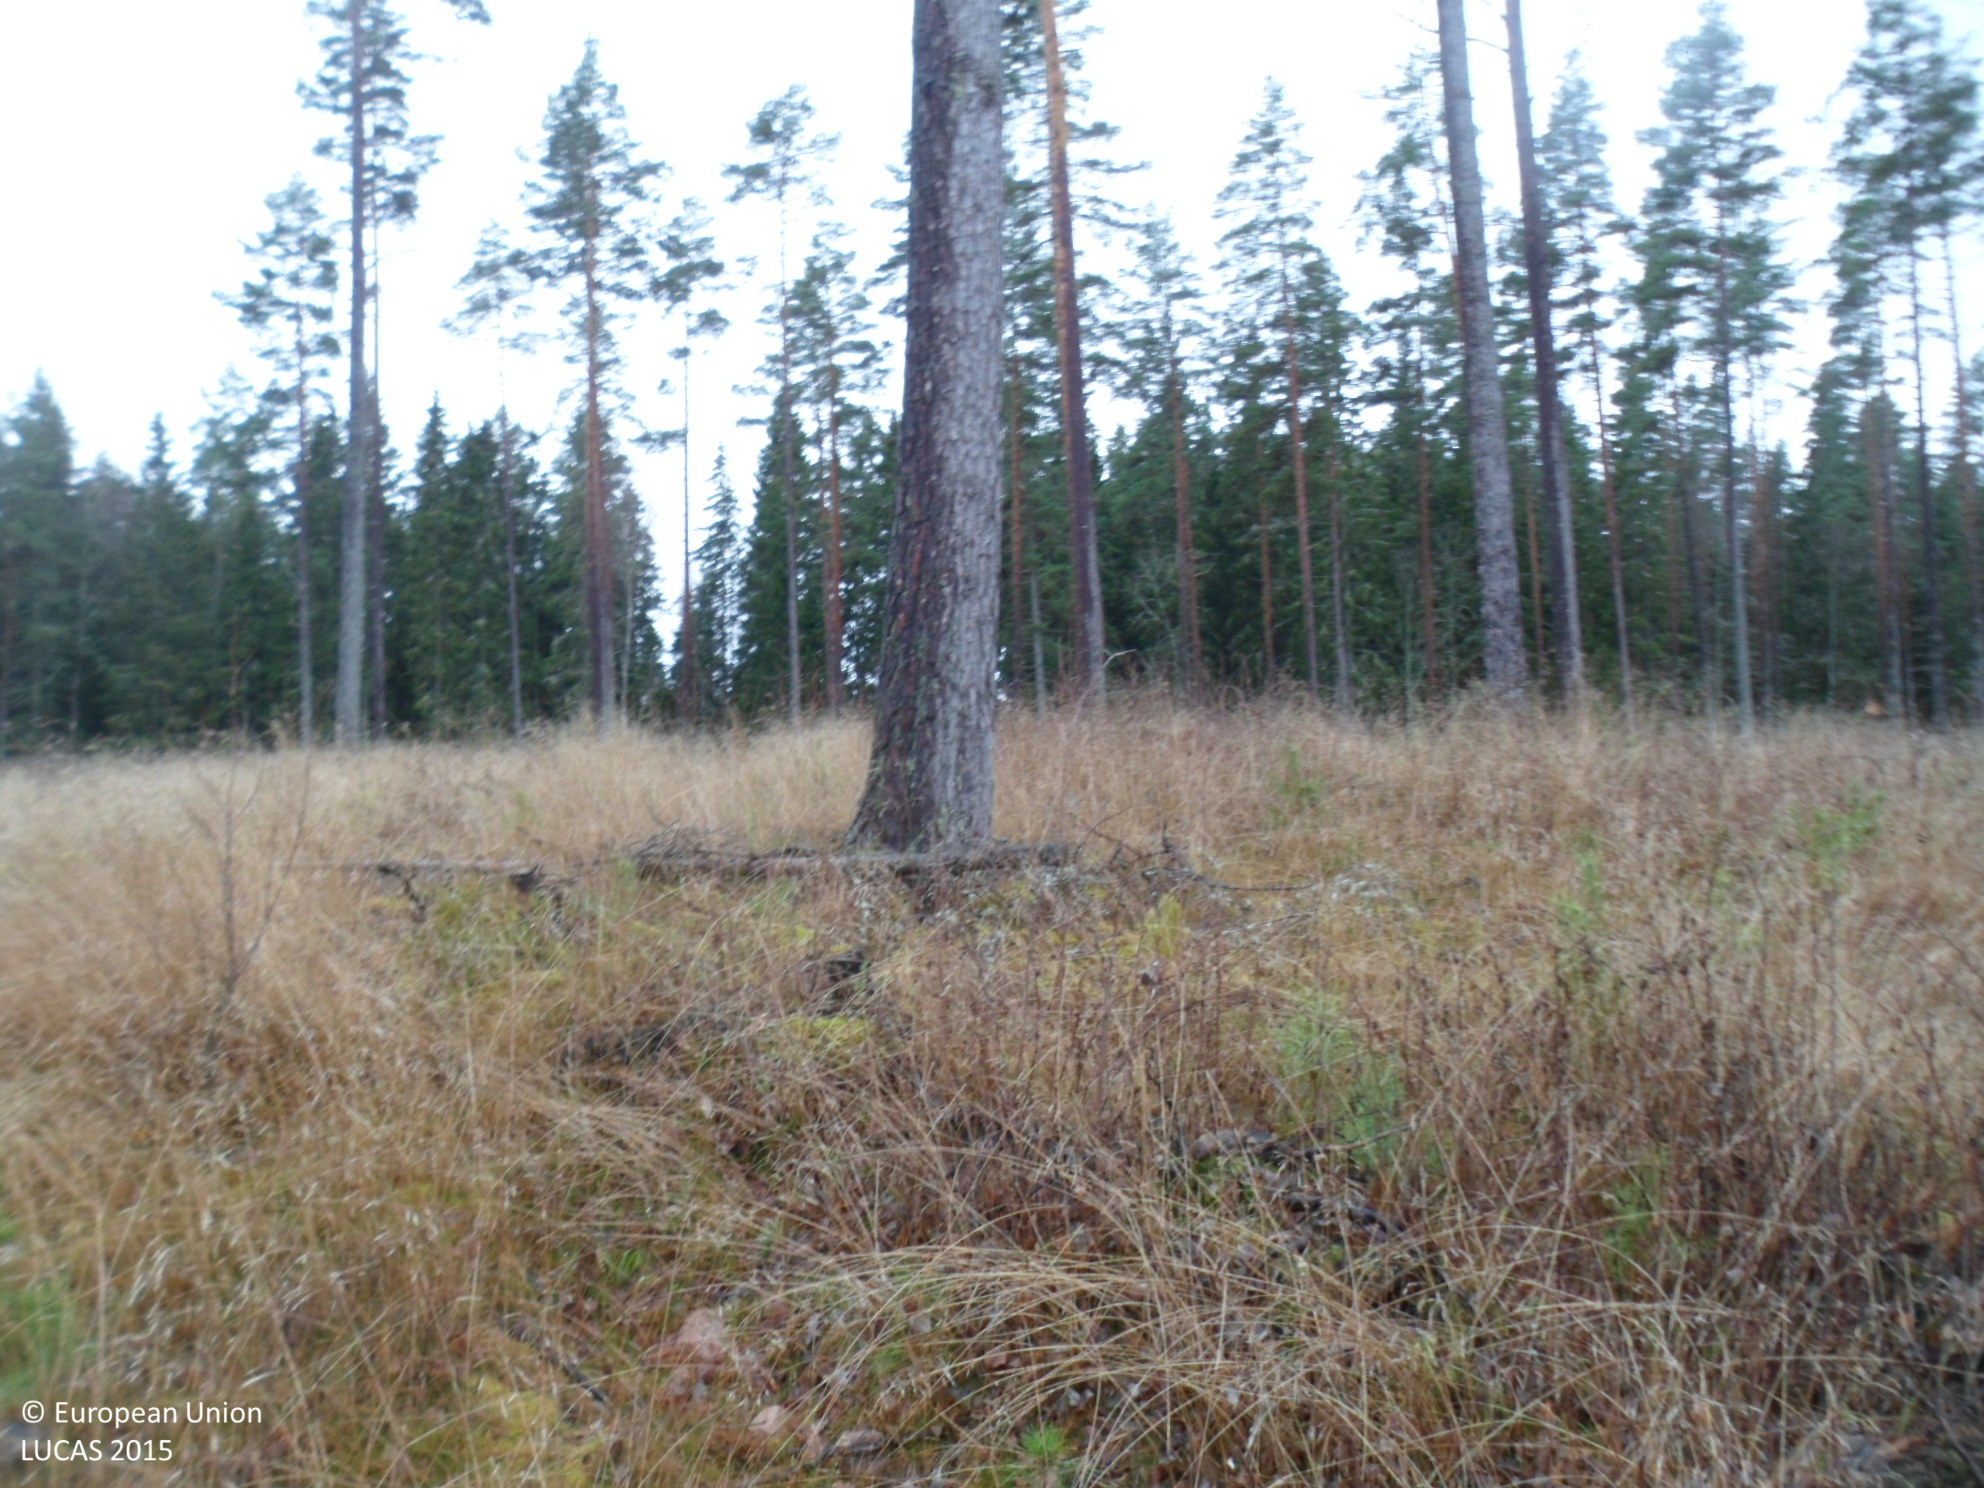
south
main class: Woodland
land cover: Pine dominated coniferous woodland
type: boreal forest
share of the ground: 25 - 50 %
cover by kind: herbaceous plants 40 %, coniferous forest trees 30 %, shrubs 20 %, broadleaved forest trees 5 %, lichens and mosses 5 %
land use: Forestry
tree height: > 5 m
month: November
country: SE
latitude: 57.7703
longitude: 14.8876
